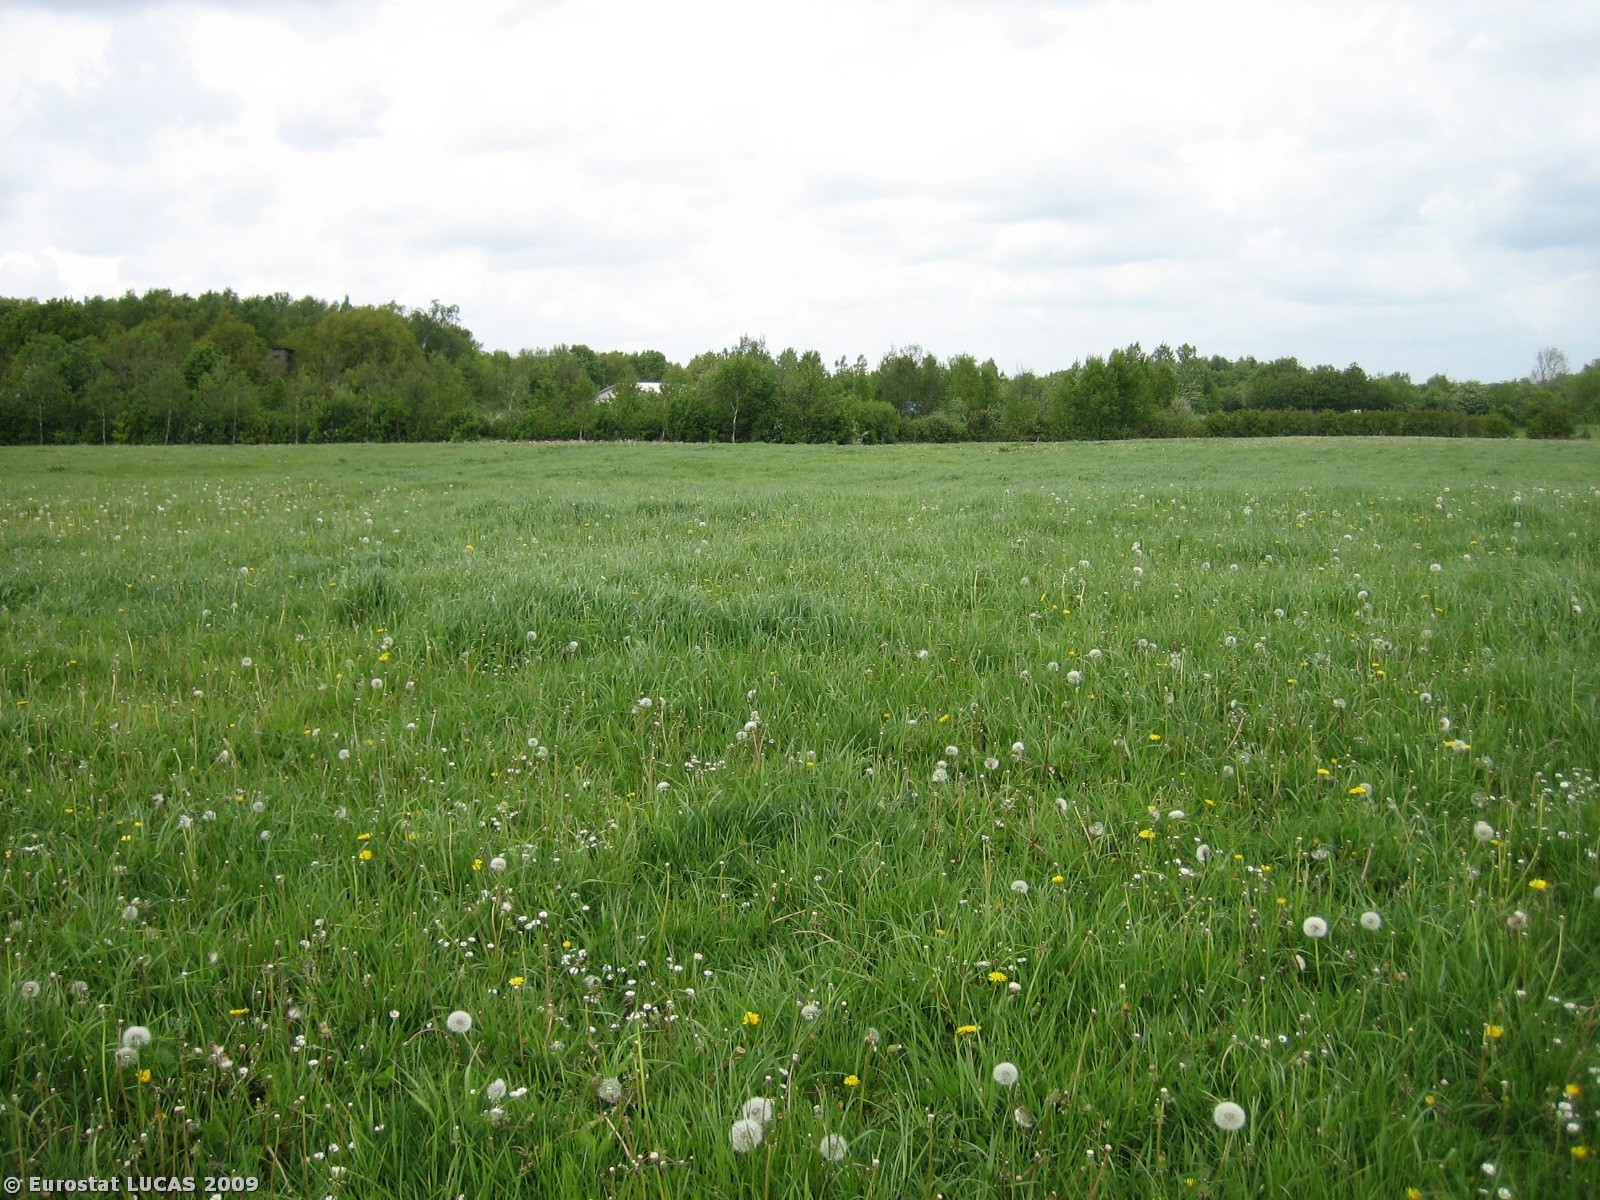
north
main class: Grassland
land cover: Grassland without tree/shrub cover
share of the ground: > 75 %
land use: Agriculture (excluding fallow land and kitchen gardens)
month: May
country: DK
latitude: 56.2186
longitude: 8.8564
